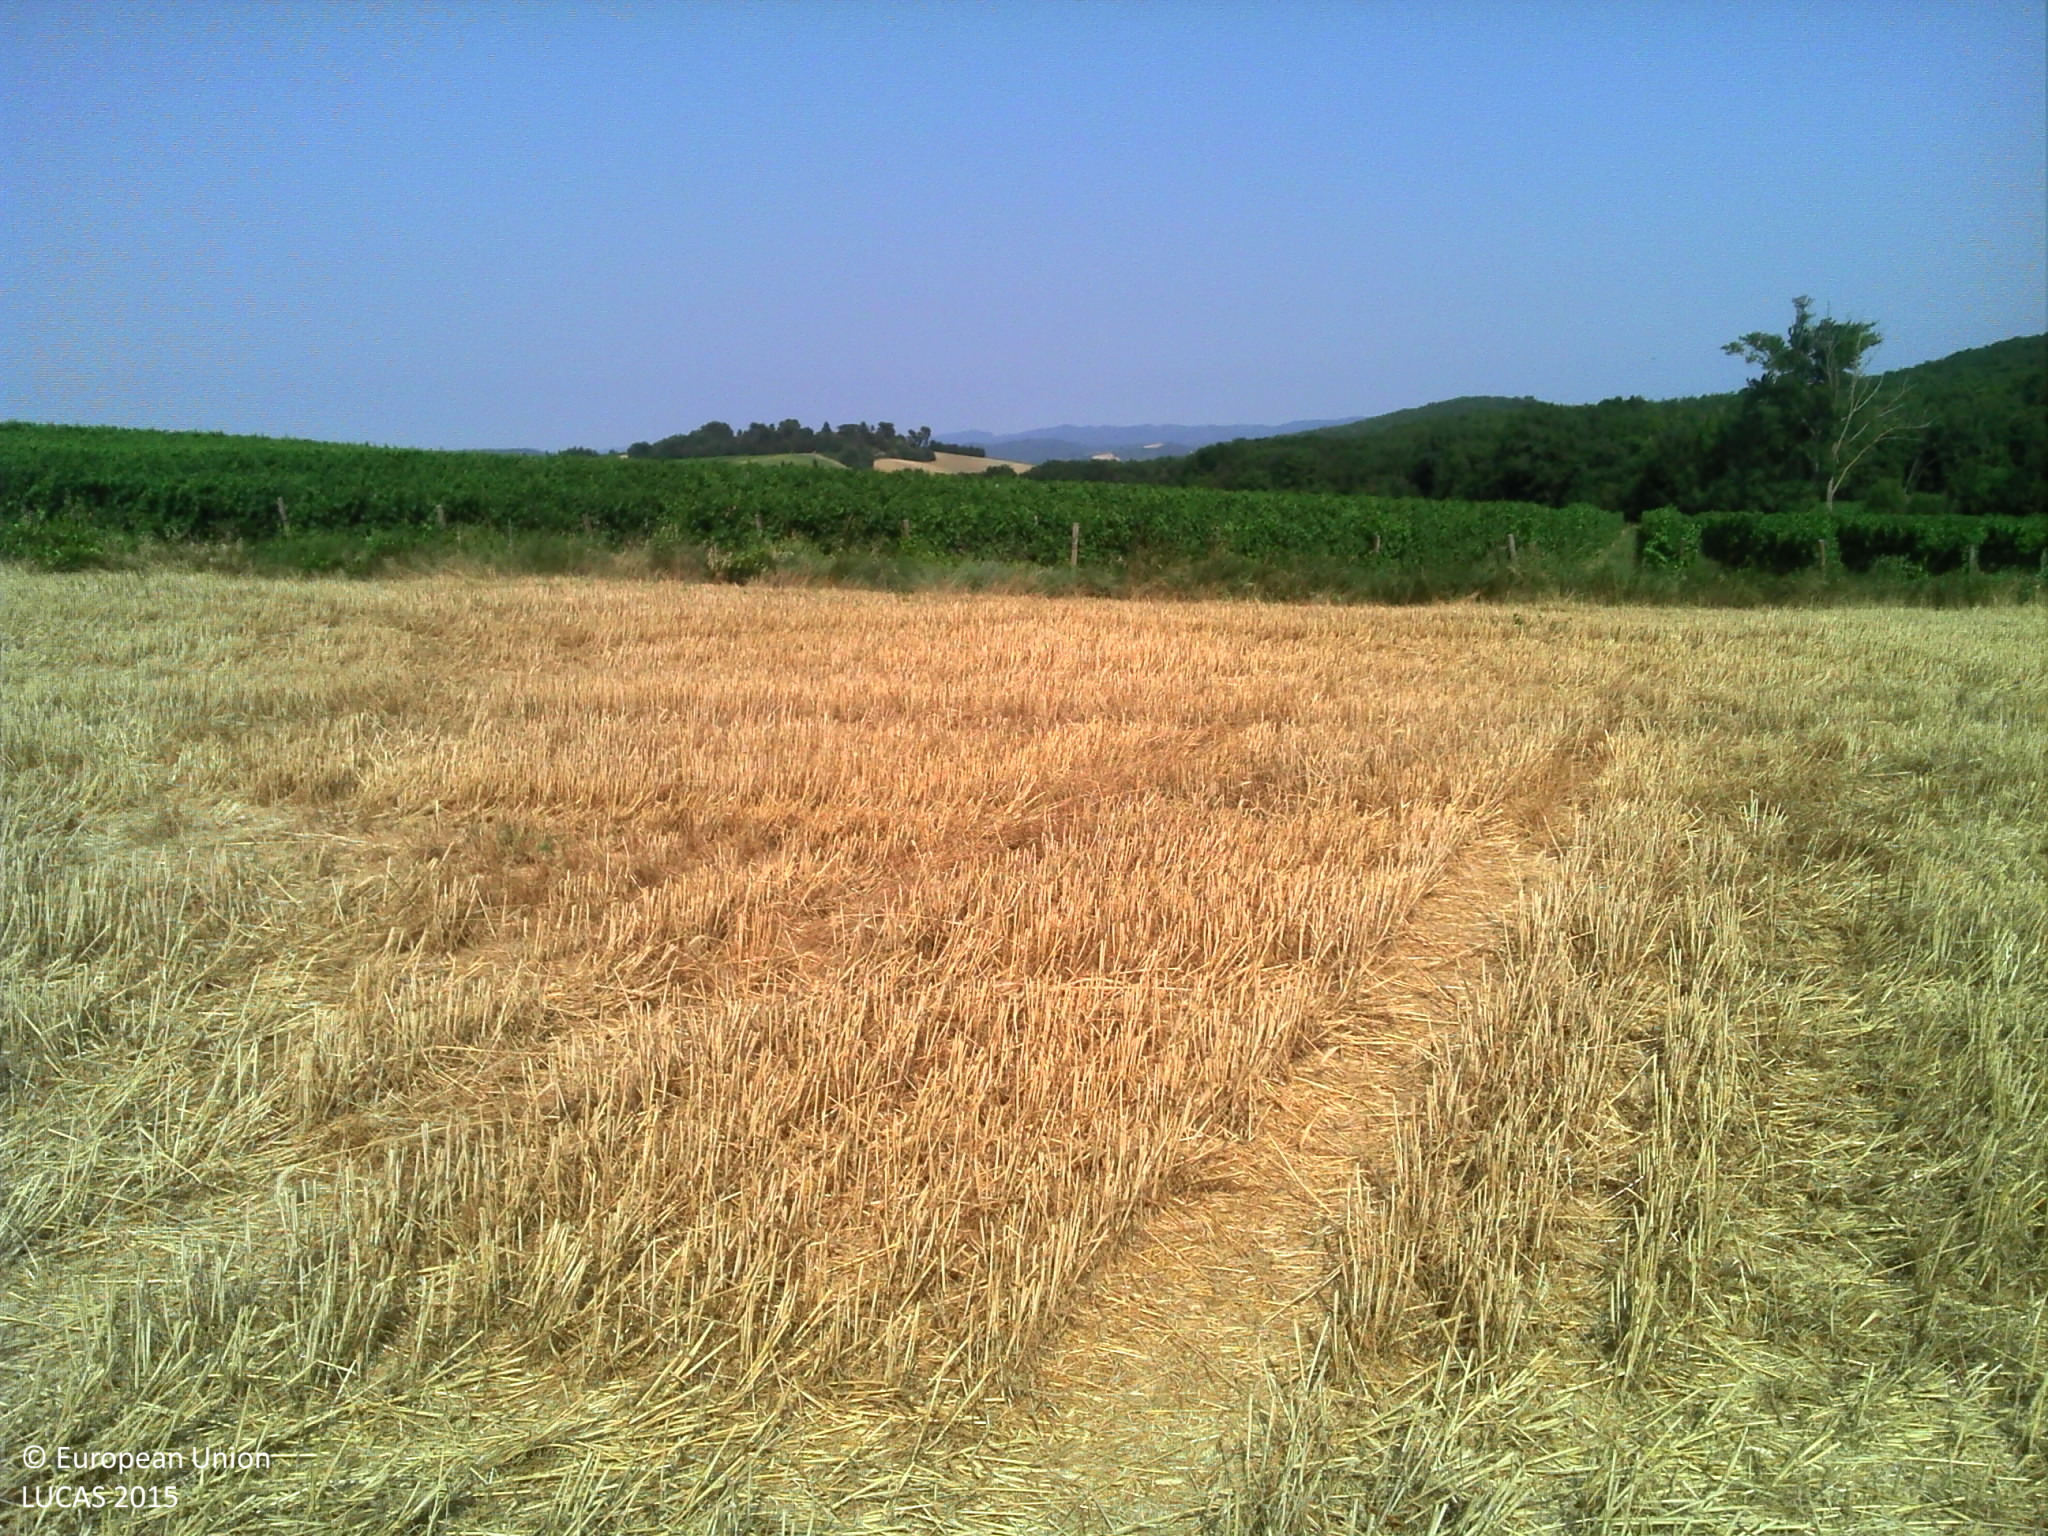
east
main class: Cropland
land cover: Durum wheat
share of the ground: > 75 %
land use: Agriculture (excluding fallow land and kitchen gardens)
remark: Harvested field
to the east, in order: Durum wheat; Grass margins; Fences; Tracks; Vineyards
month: July
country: FR
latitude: 43.0912
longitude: 2.1334
